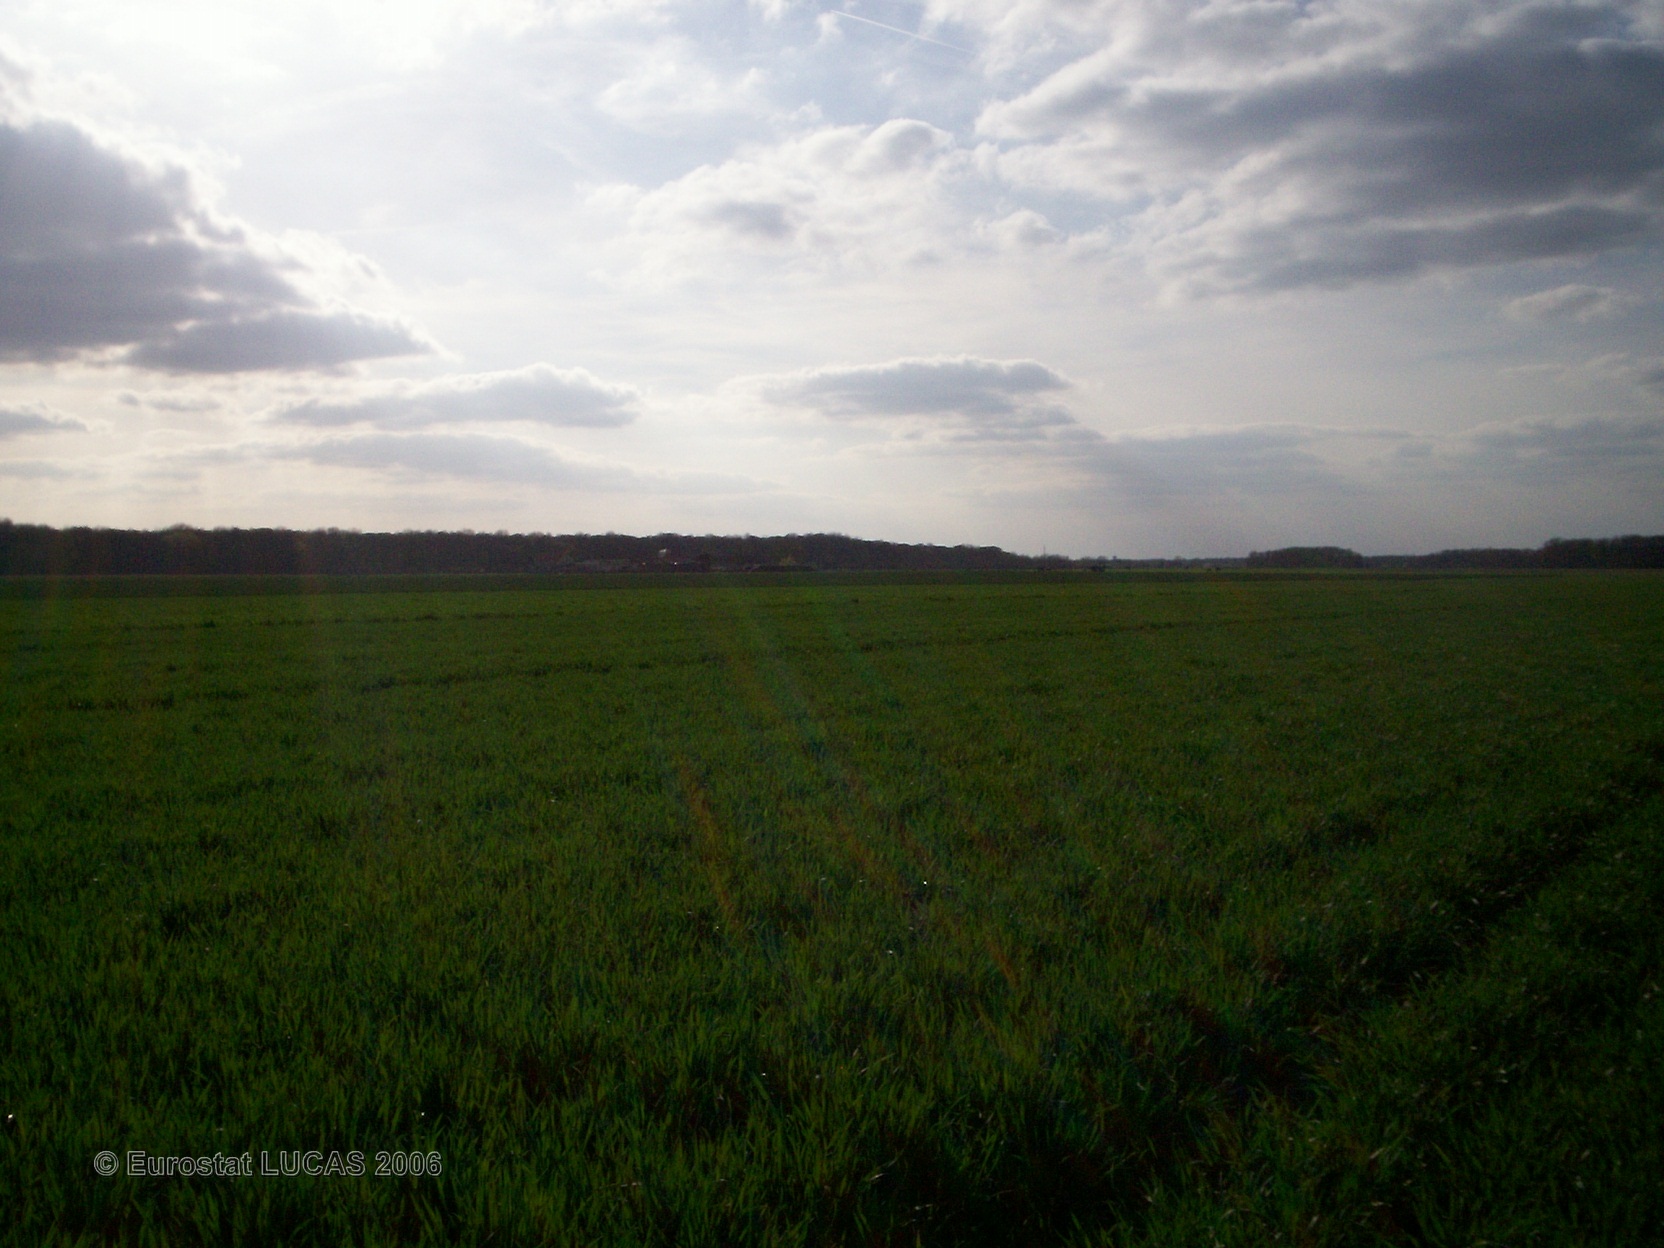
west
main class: Cropland
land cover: Common wheat
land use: Agriculture (excluding fallow land and kitchen gardens)
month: April
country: FR
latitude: 48.4762
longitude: 2.8080
